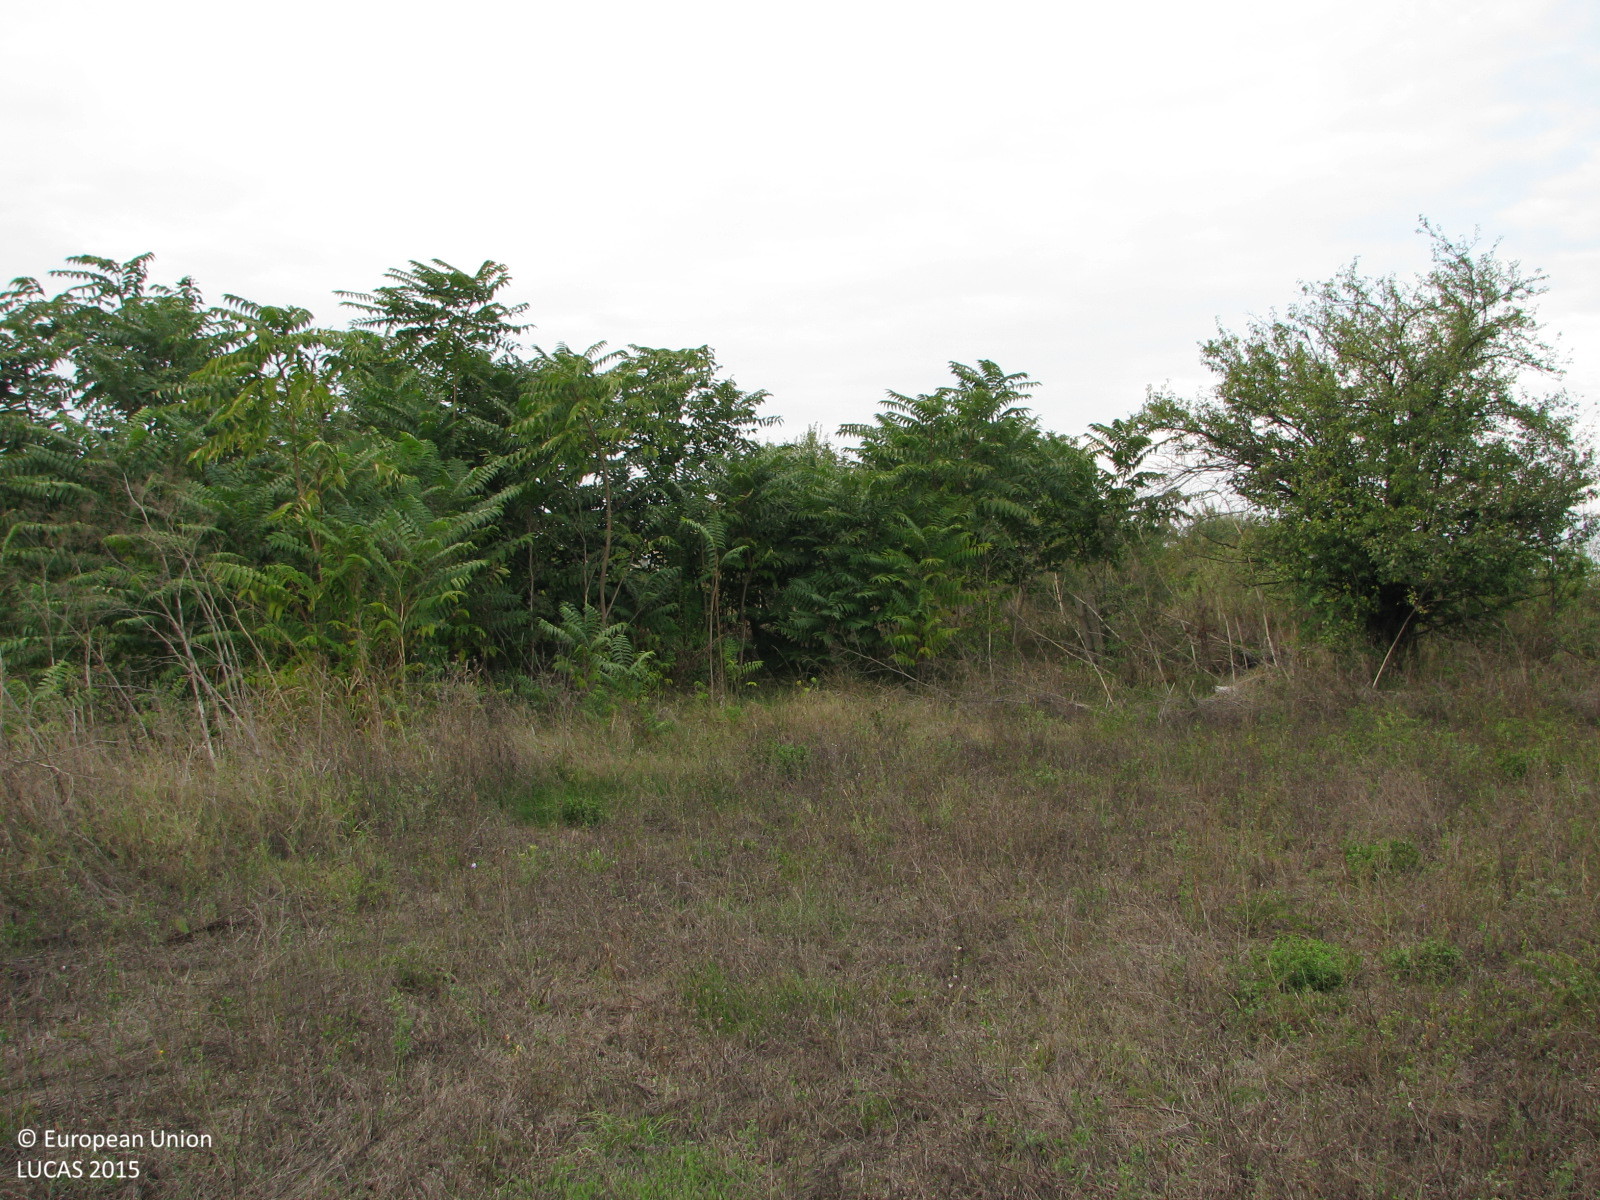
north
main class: Cropland
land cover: Lucerne
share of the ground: 25 - 50 %
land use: Agriculture (excluding fallow land and kitchen gardens)
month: October
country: BG
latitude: 42.2797
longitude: 26.5207
